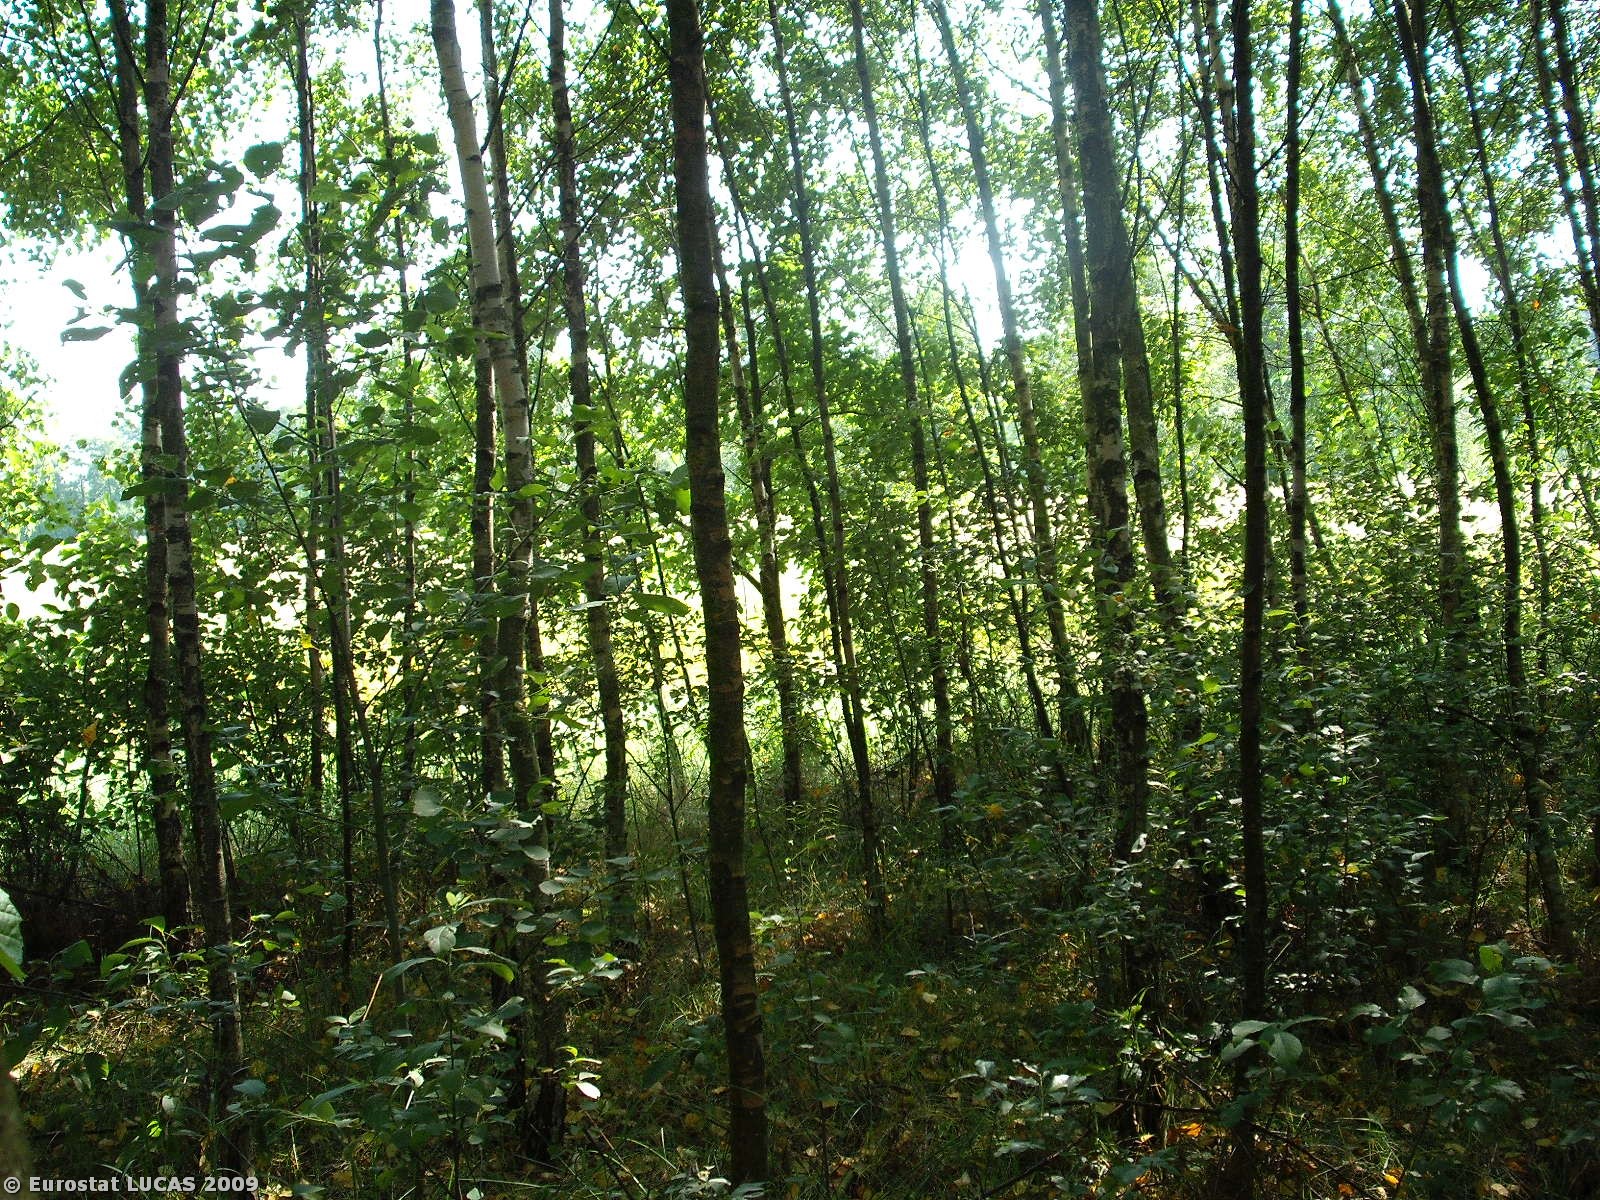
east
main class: Woodland
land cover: Broadleaved woodland
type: non-riverine alder, birch or aspen forest
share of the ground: > 75 %
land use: Forestry
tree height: > 5 m
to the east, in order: Broadleaved woodland; Oats; Groves; Tracks; Grassland without tree/shrub cover; Tracks; Grassland without tree/shrub cover; Potatoes; Grass margins; Oats; Tracks; Lines of trees; Ditches and canals; Spontaneously vegetated surfaces; Lines of trees; Grassland without tree/shrub cover
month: July
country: PL
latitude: 51.9705
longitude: 21.5956
